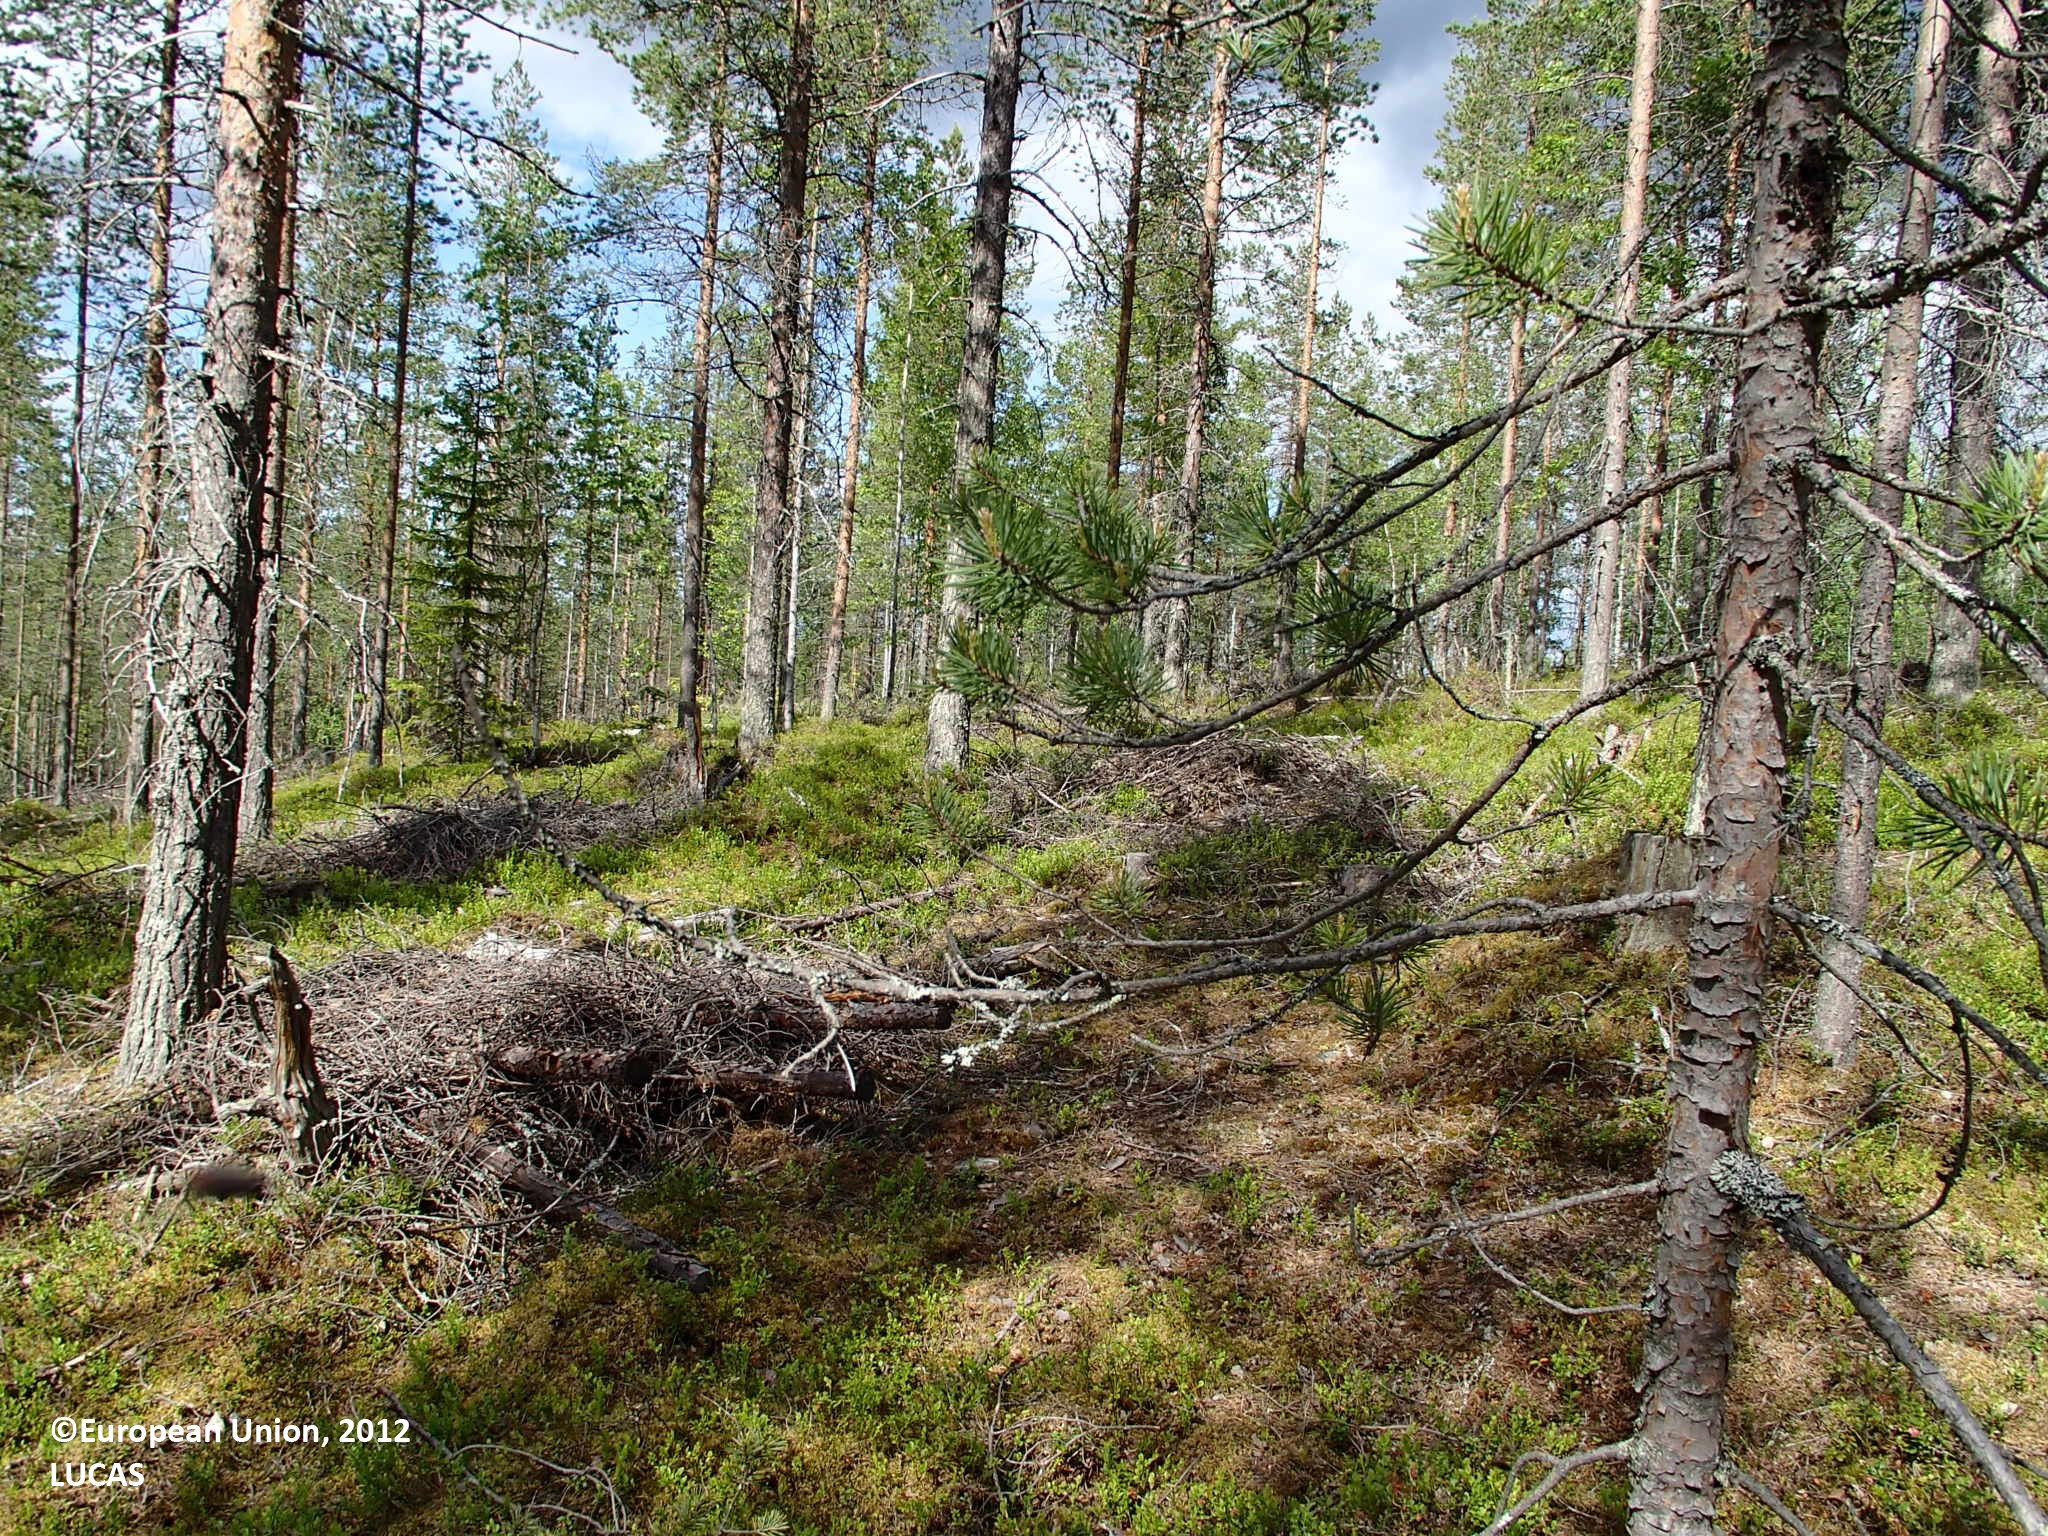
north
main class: Woodland
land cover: Pine dominated coniferous woodland
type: boreal forest
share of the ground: 50 - 75 %
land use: Forestry
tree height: > 5 m
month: June
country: FI
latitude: 66.5696
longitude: 27.2567
